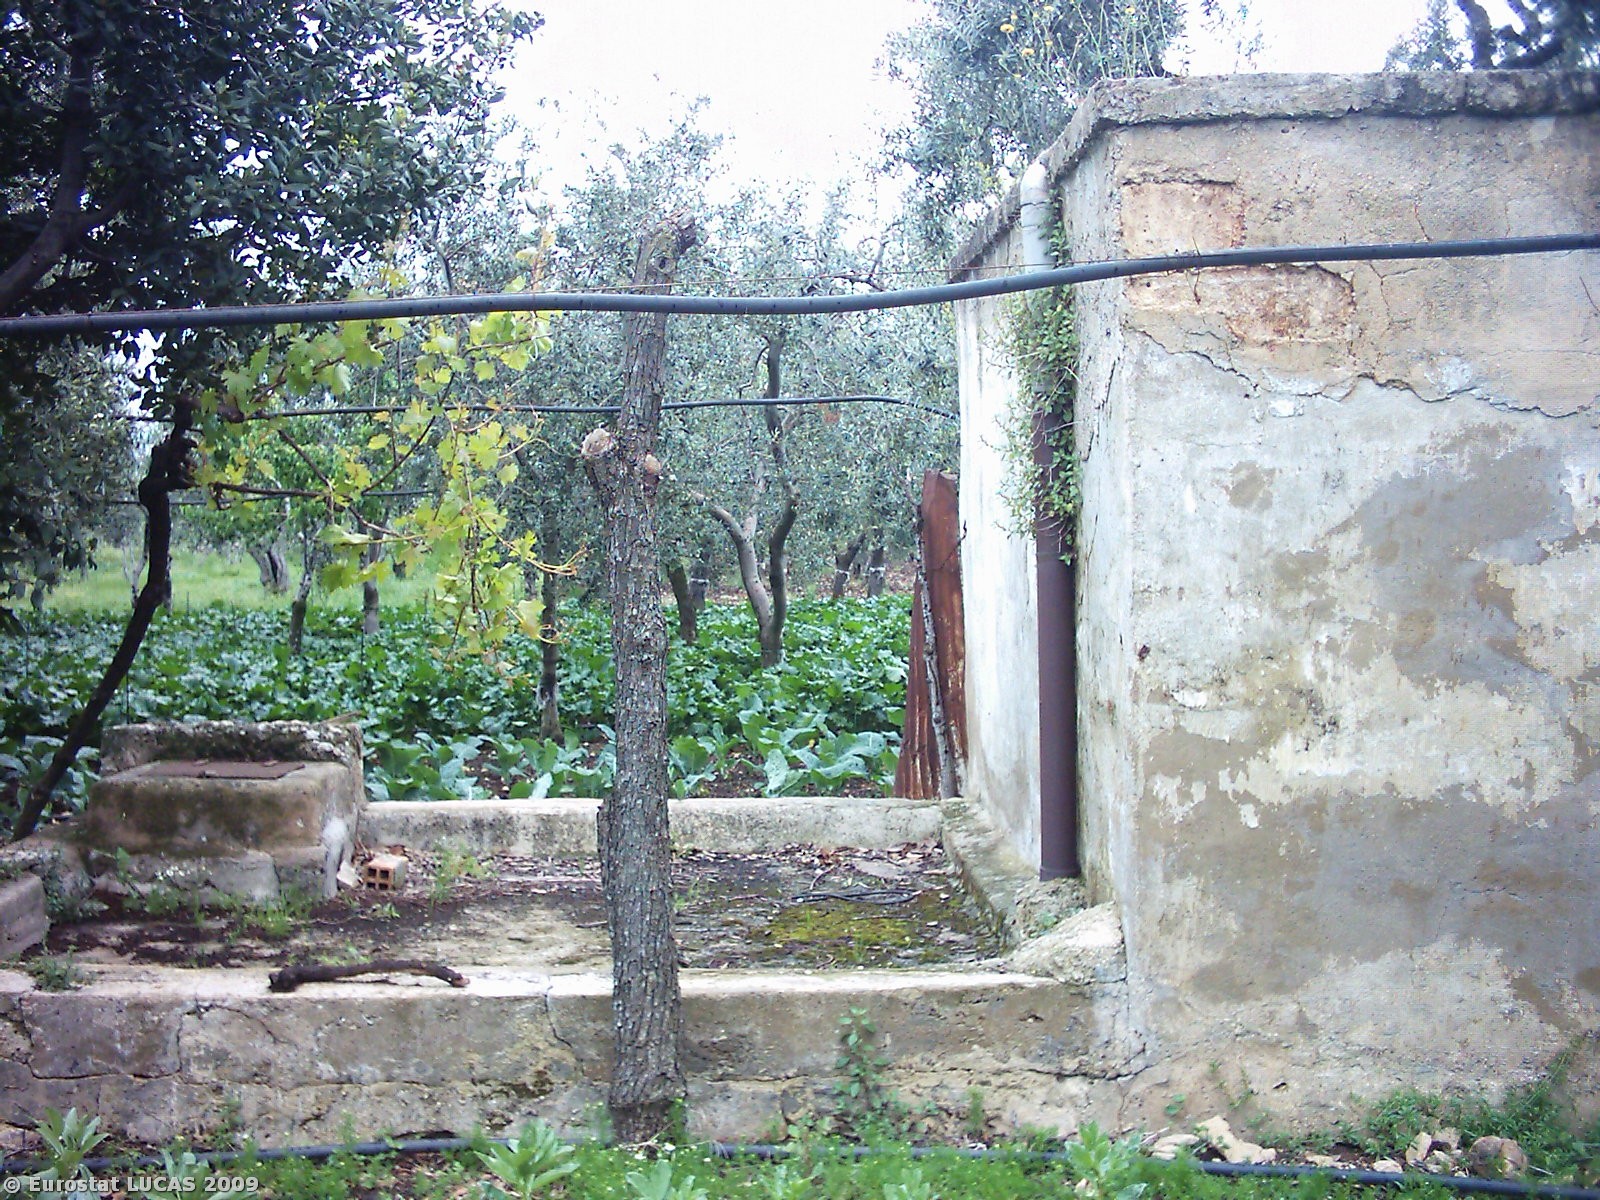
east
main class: Artificial land
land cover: Buildings with 1 to 3 floors
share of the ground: > 75 %
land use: Logistics and storage
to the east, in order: Buildings with 1 to 3 floors; Olive groves; Other fresh vegetables; Artificial constructions in urban areas; Olive groves; Other fresh vegetables; Artificial constructions; Olive groves; Bare land; Grass margins; Paved roads, cycling and walking lanes; Grass margins; Dry stone walls; Olive groves; Spontaneously vegetated surfaces; Dry stone walls; Olive groves; Durum wheat
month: April
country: IT
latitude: 41.0936
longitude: 16.9201
